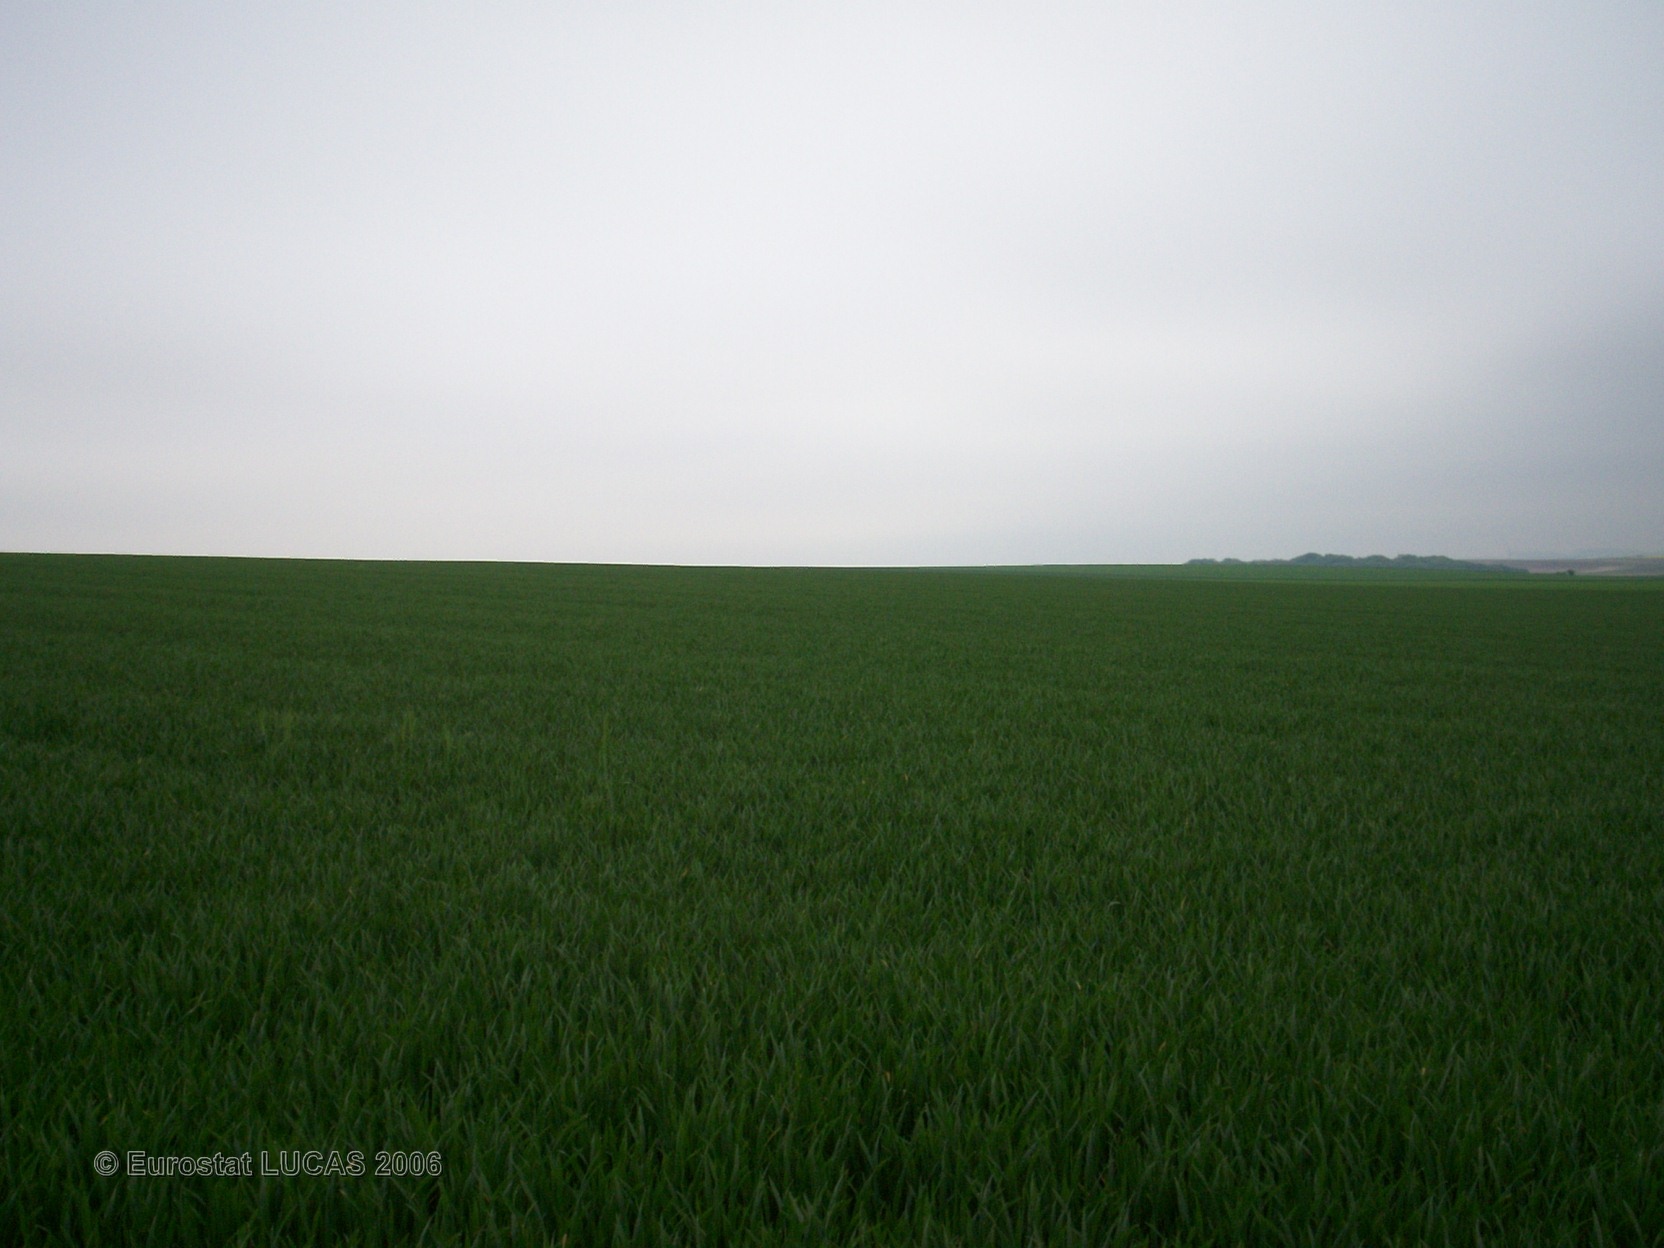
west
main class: Cropland
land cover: Common wheat
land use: Agriculture (excluding fallow land and kitchen gardens)
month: May
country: FR
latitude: 49.5018
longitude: 4.3204
